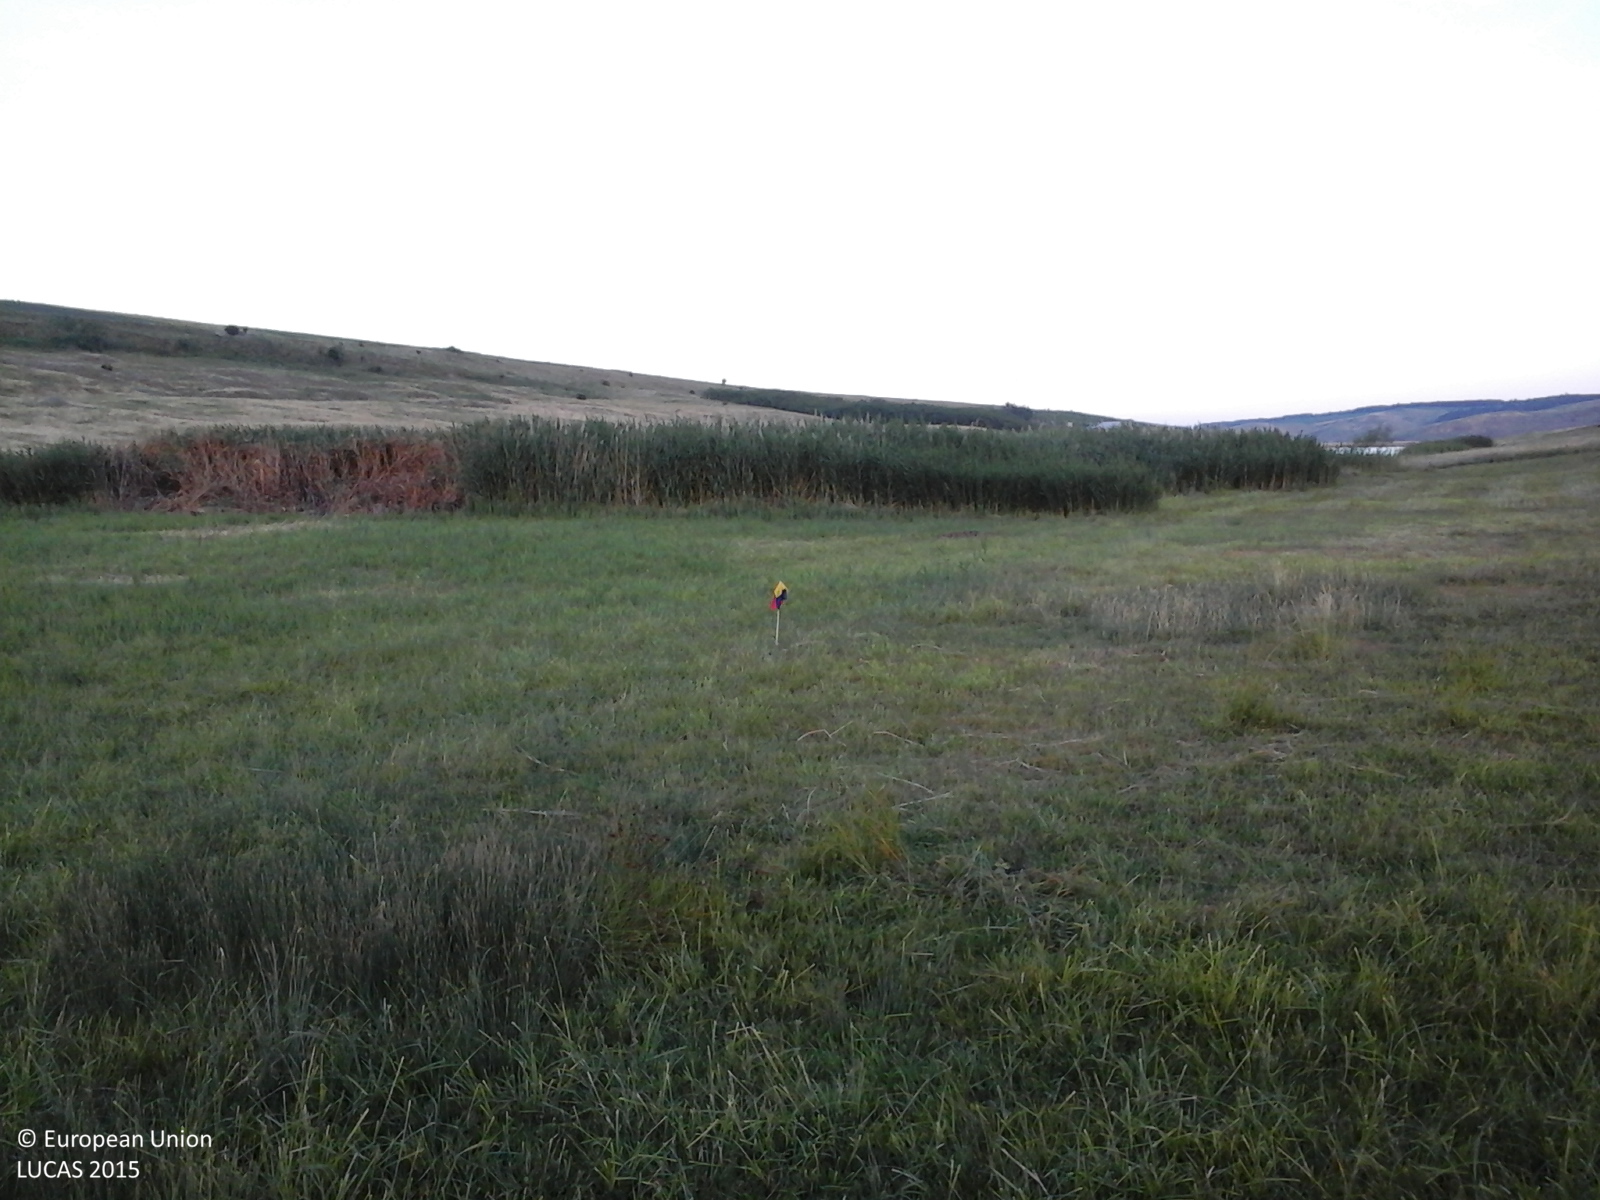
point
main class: Grassland
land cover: Grassland without tree/shrub cover
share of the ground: > 75 %
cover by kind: herbaceous plants 100 %
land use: Agriculture (excluding fallow land and kitchen gardens)
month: June
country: RO
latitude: 47.4411
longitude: 27.1194
